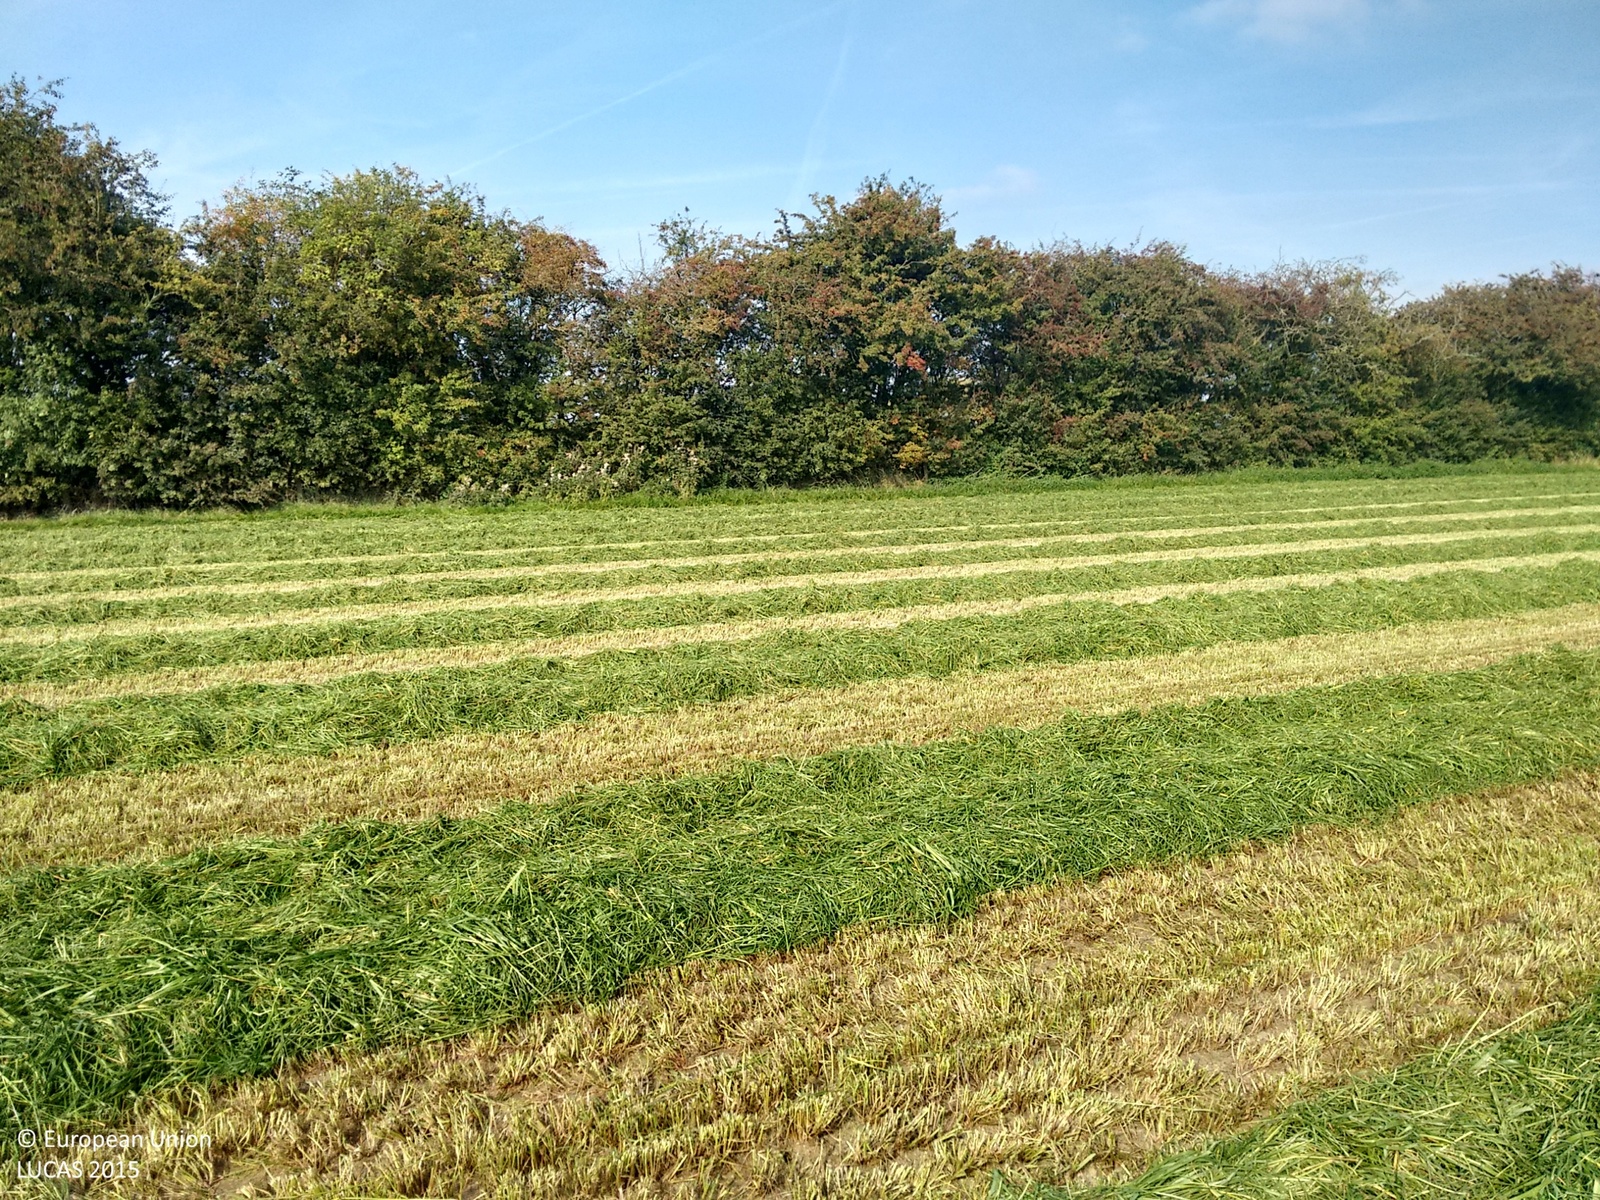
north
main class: Grassland
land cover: Grassland without tree/shrub cover
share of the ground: > 75 %
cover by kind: herbaceous plants 100 %
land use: Agriculture (excluding fallow land and kitchen gardens)
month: September
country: GB
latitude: 52.7698
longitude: -2.3208
